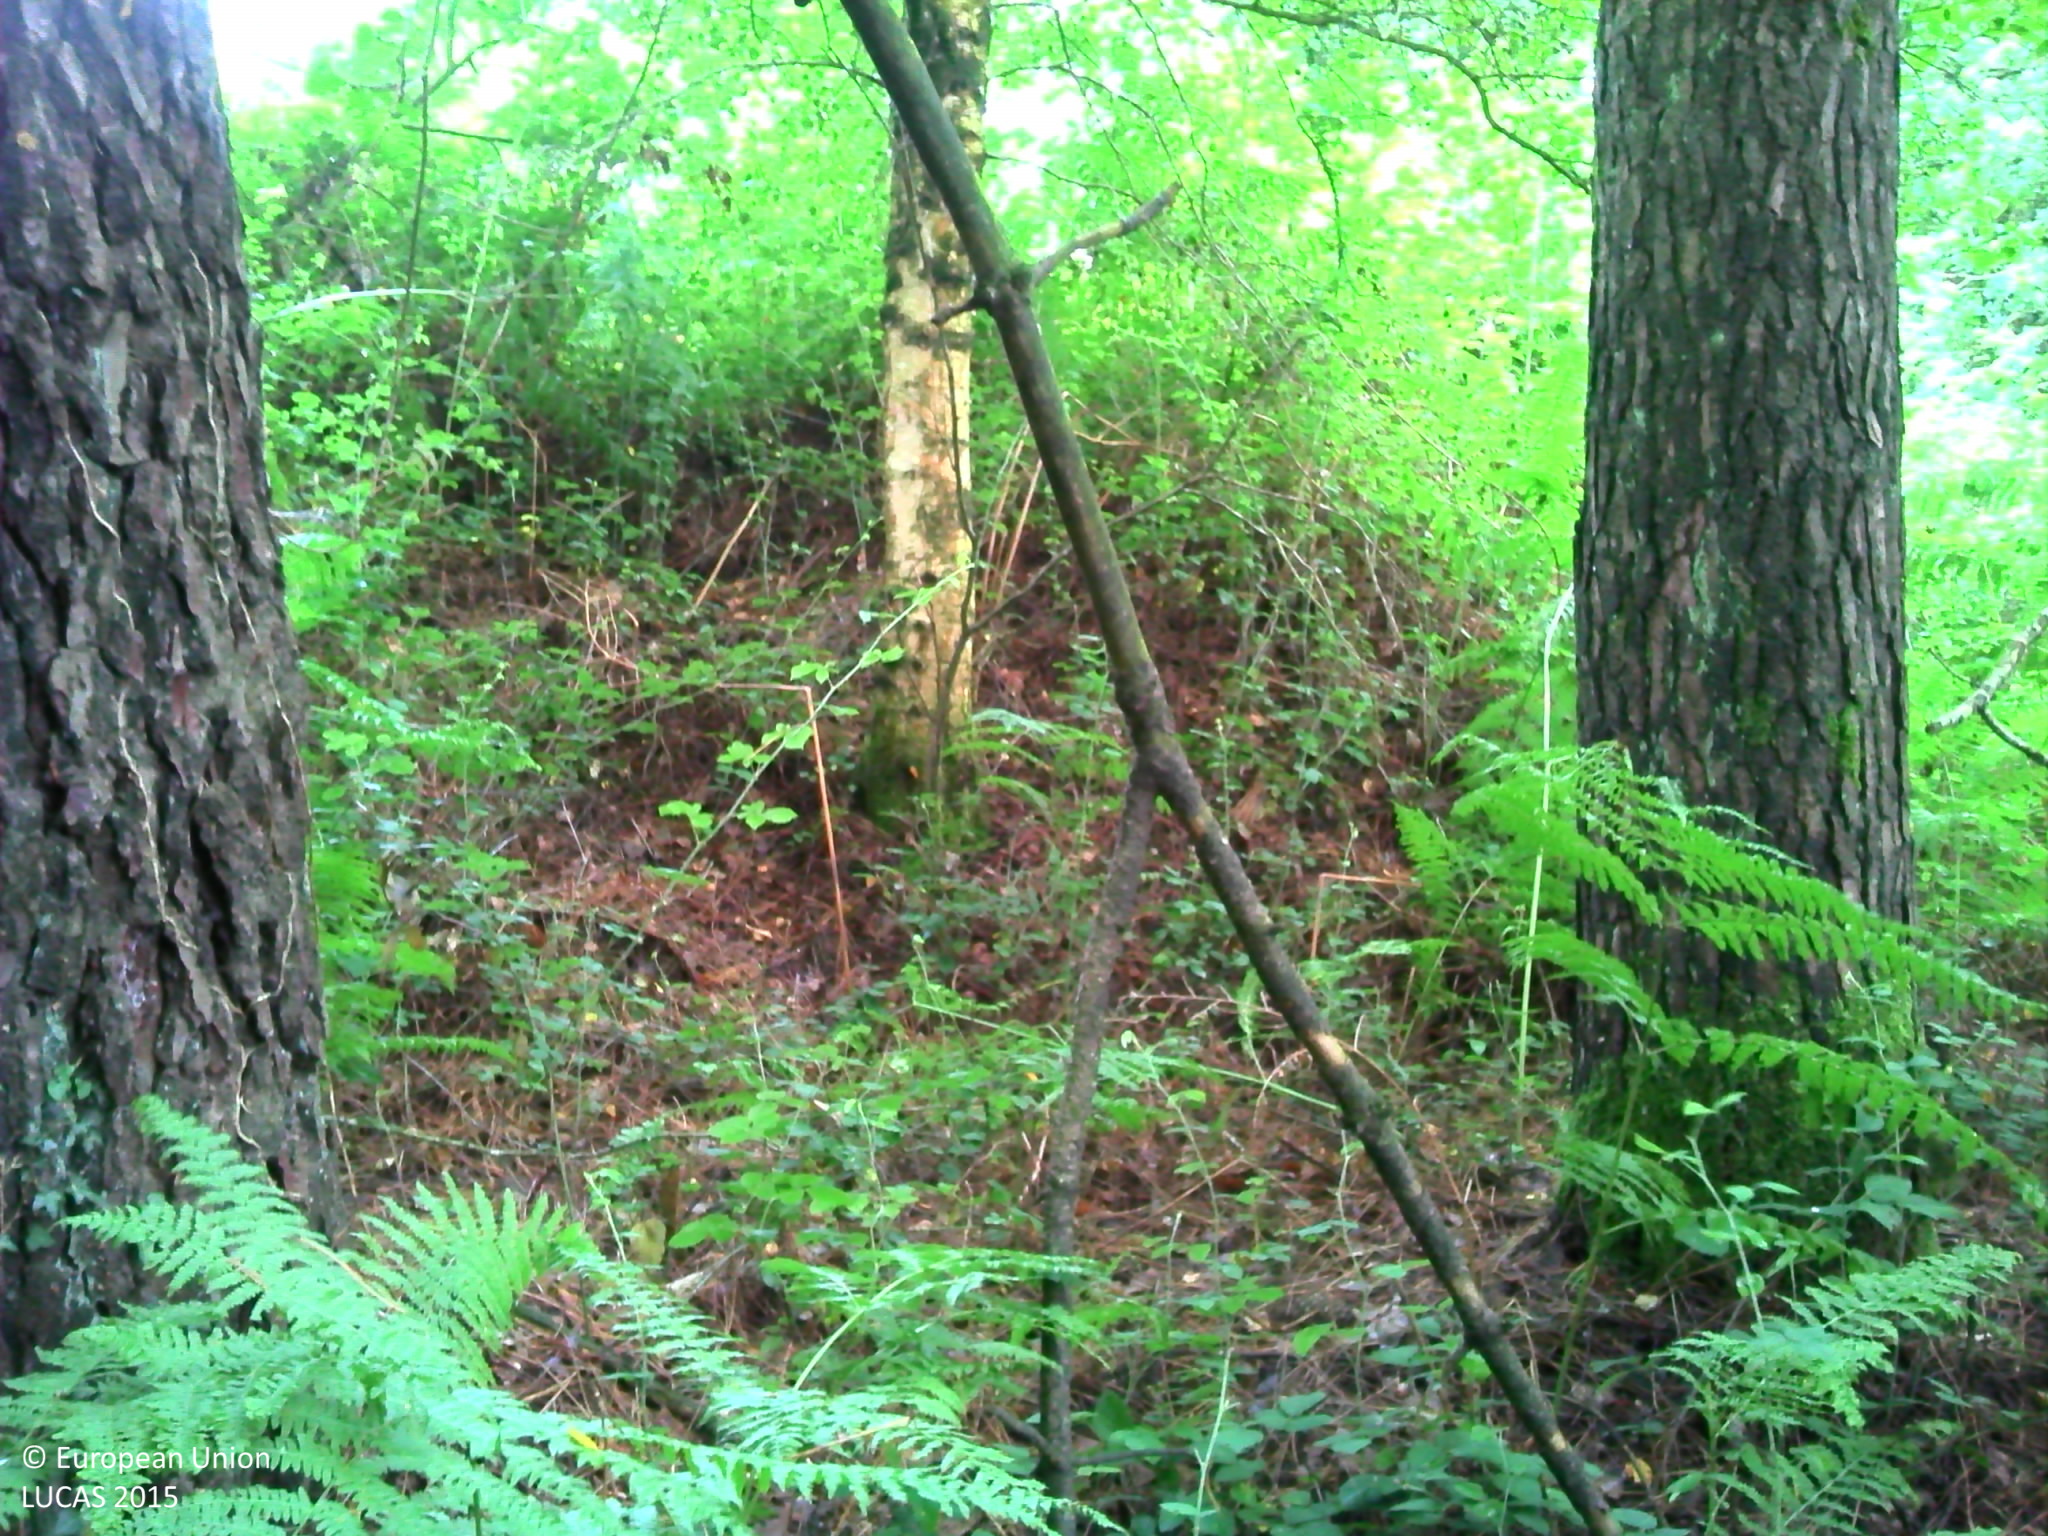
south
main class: Woodland
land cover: Other mixed woodland
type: exotic forest
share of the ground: > 75 %
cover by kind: broadleaved forest trees 40 %, coniferous forest trees 30 %, shrubs 10 %, herbaceous plants 10 %, consolidated bare surface 10 %
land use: Forestry
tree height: > 5 m
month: July
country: FR
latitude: 47.8405
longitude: -2.9330
